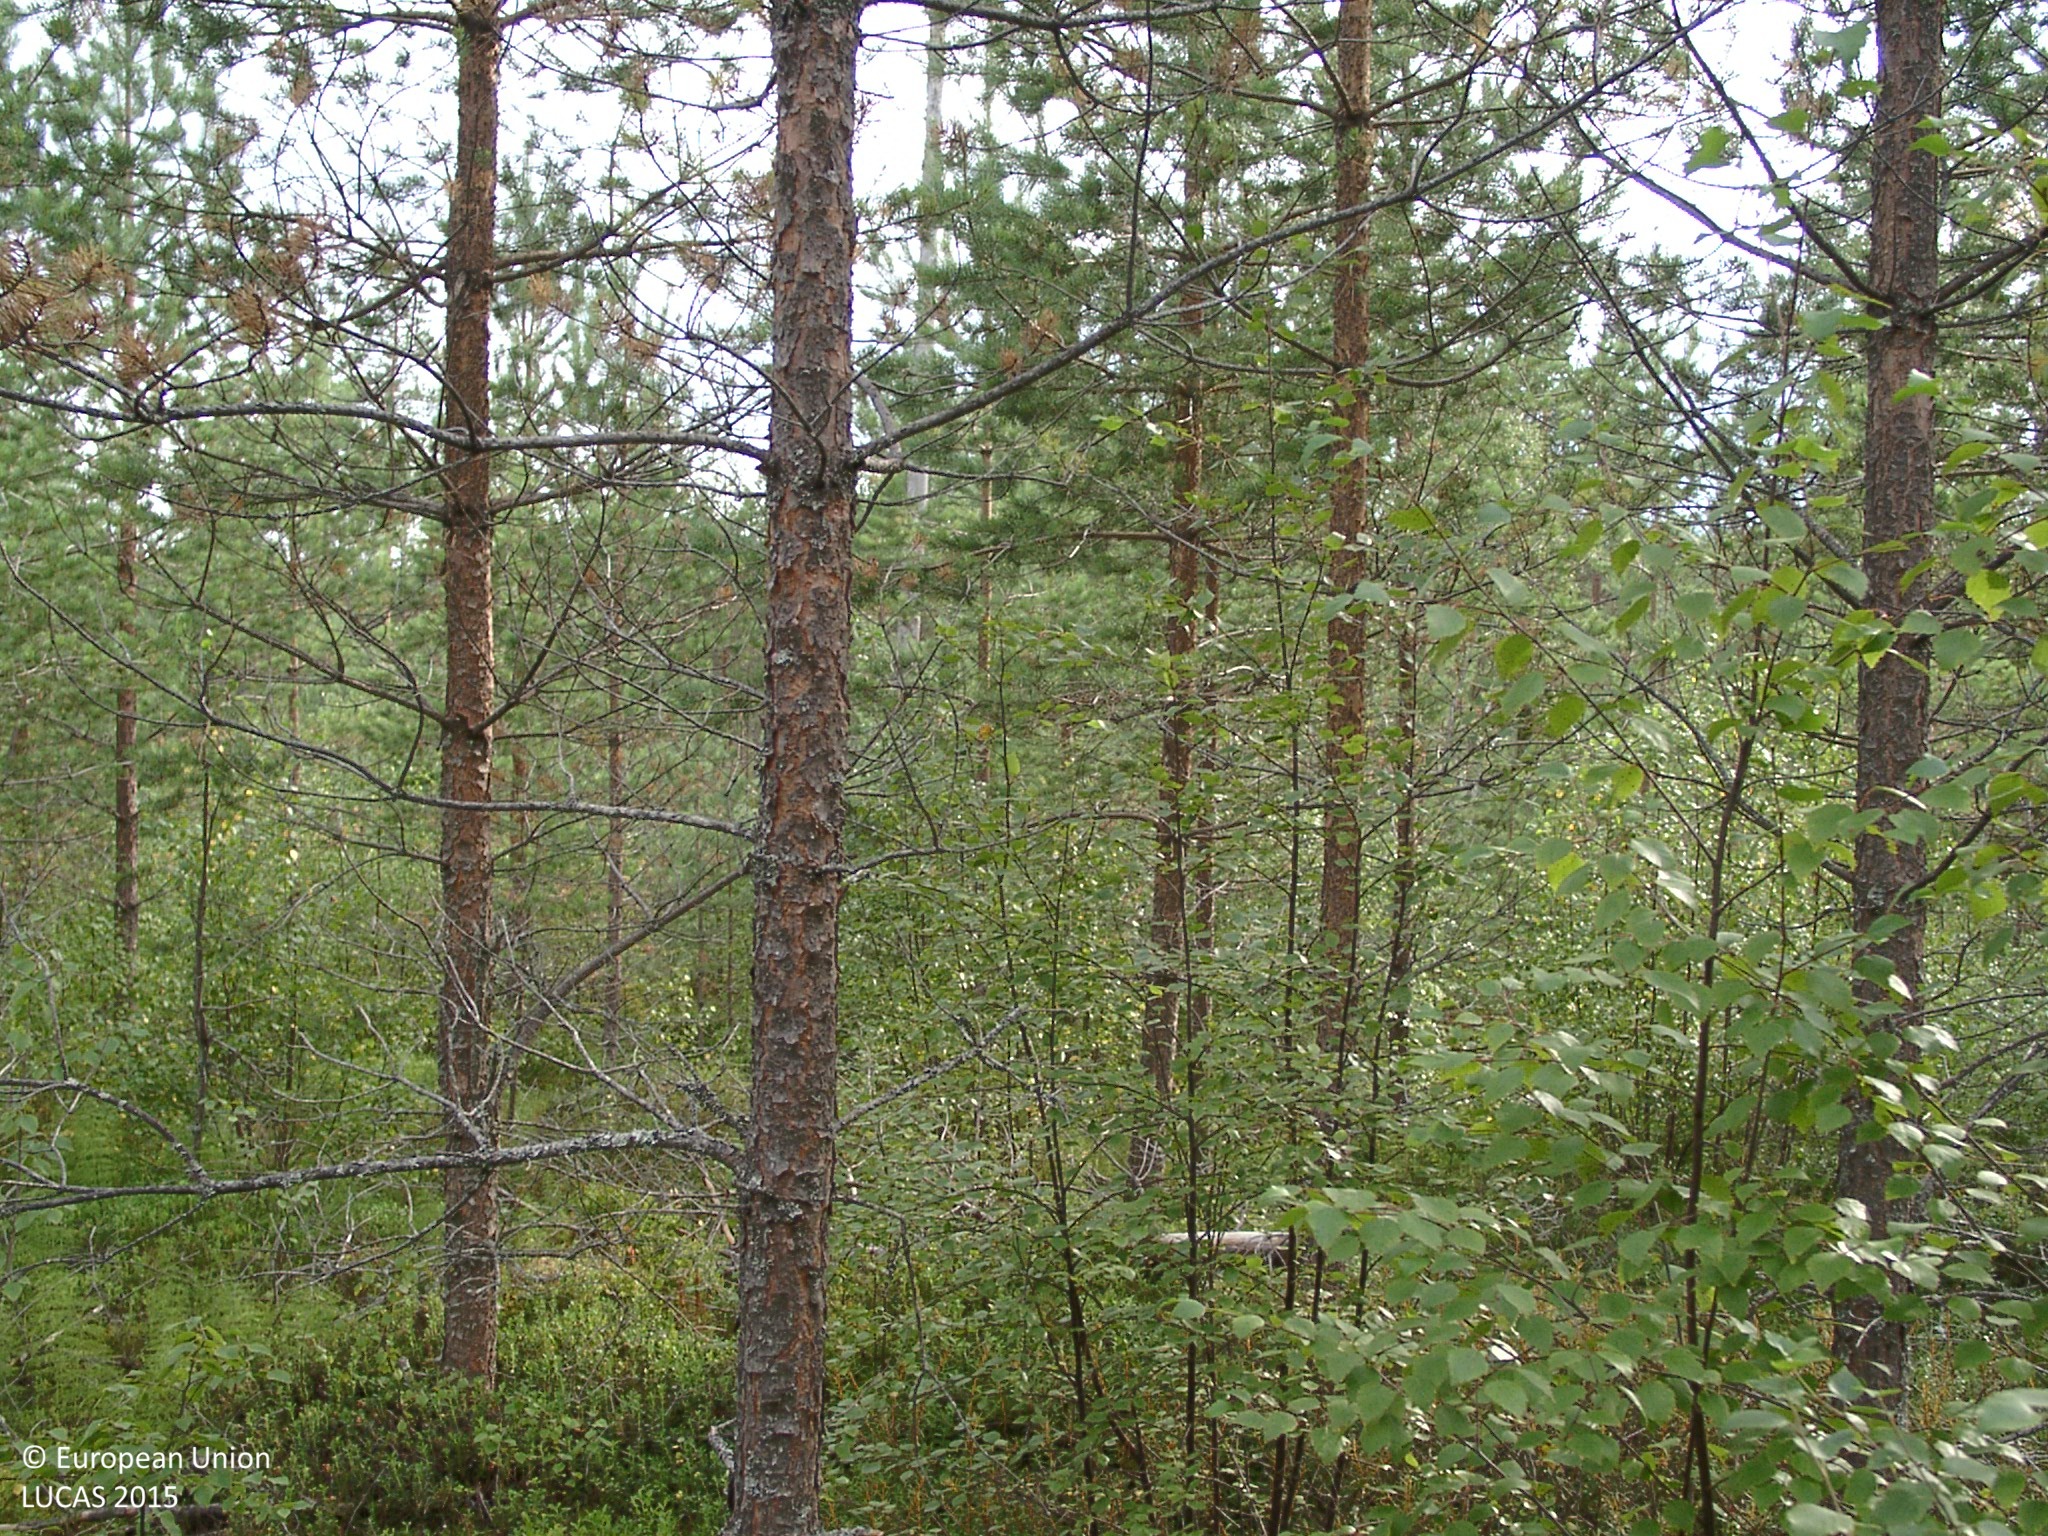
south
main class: Woodland
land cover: Pine dominated coniferous woodland
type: boreal forest
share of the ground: 50 - 75 %
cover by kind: coniferous forest trees 55 %, shrubs 25 %, broadleaved forest trees 10 %, lichens and mosses 10 %
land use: Forestry
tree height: < 5 m
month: August
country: FI
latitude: 62.5668
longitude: 24.5061
